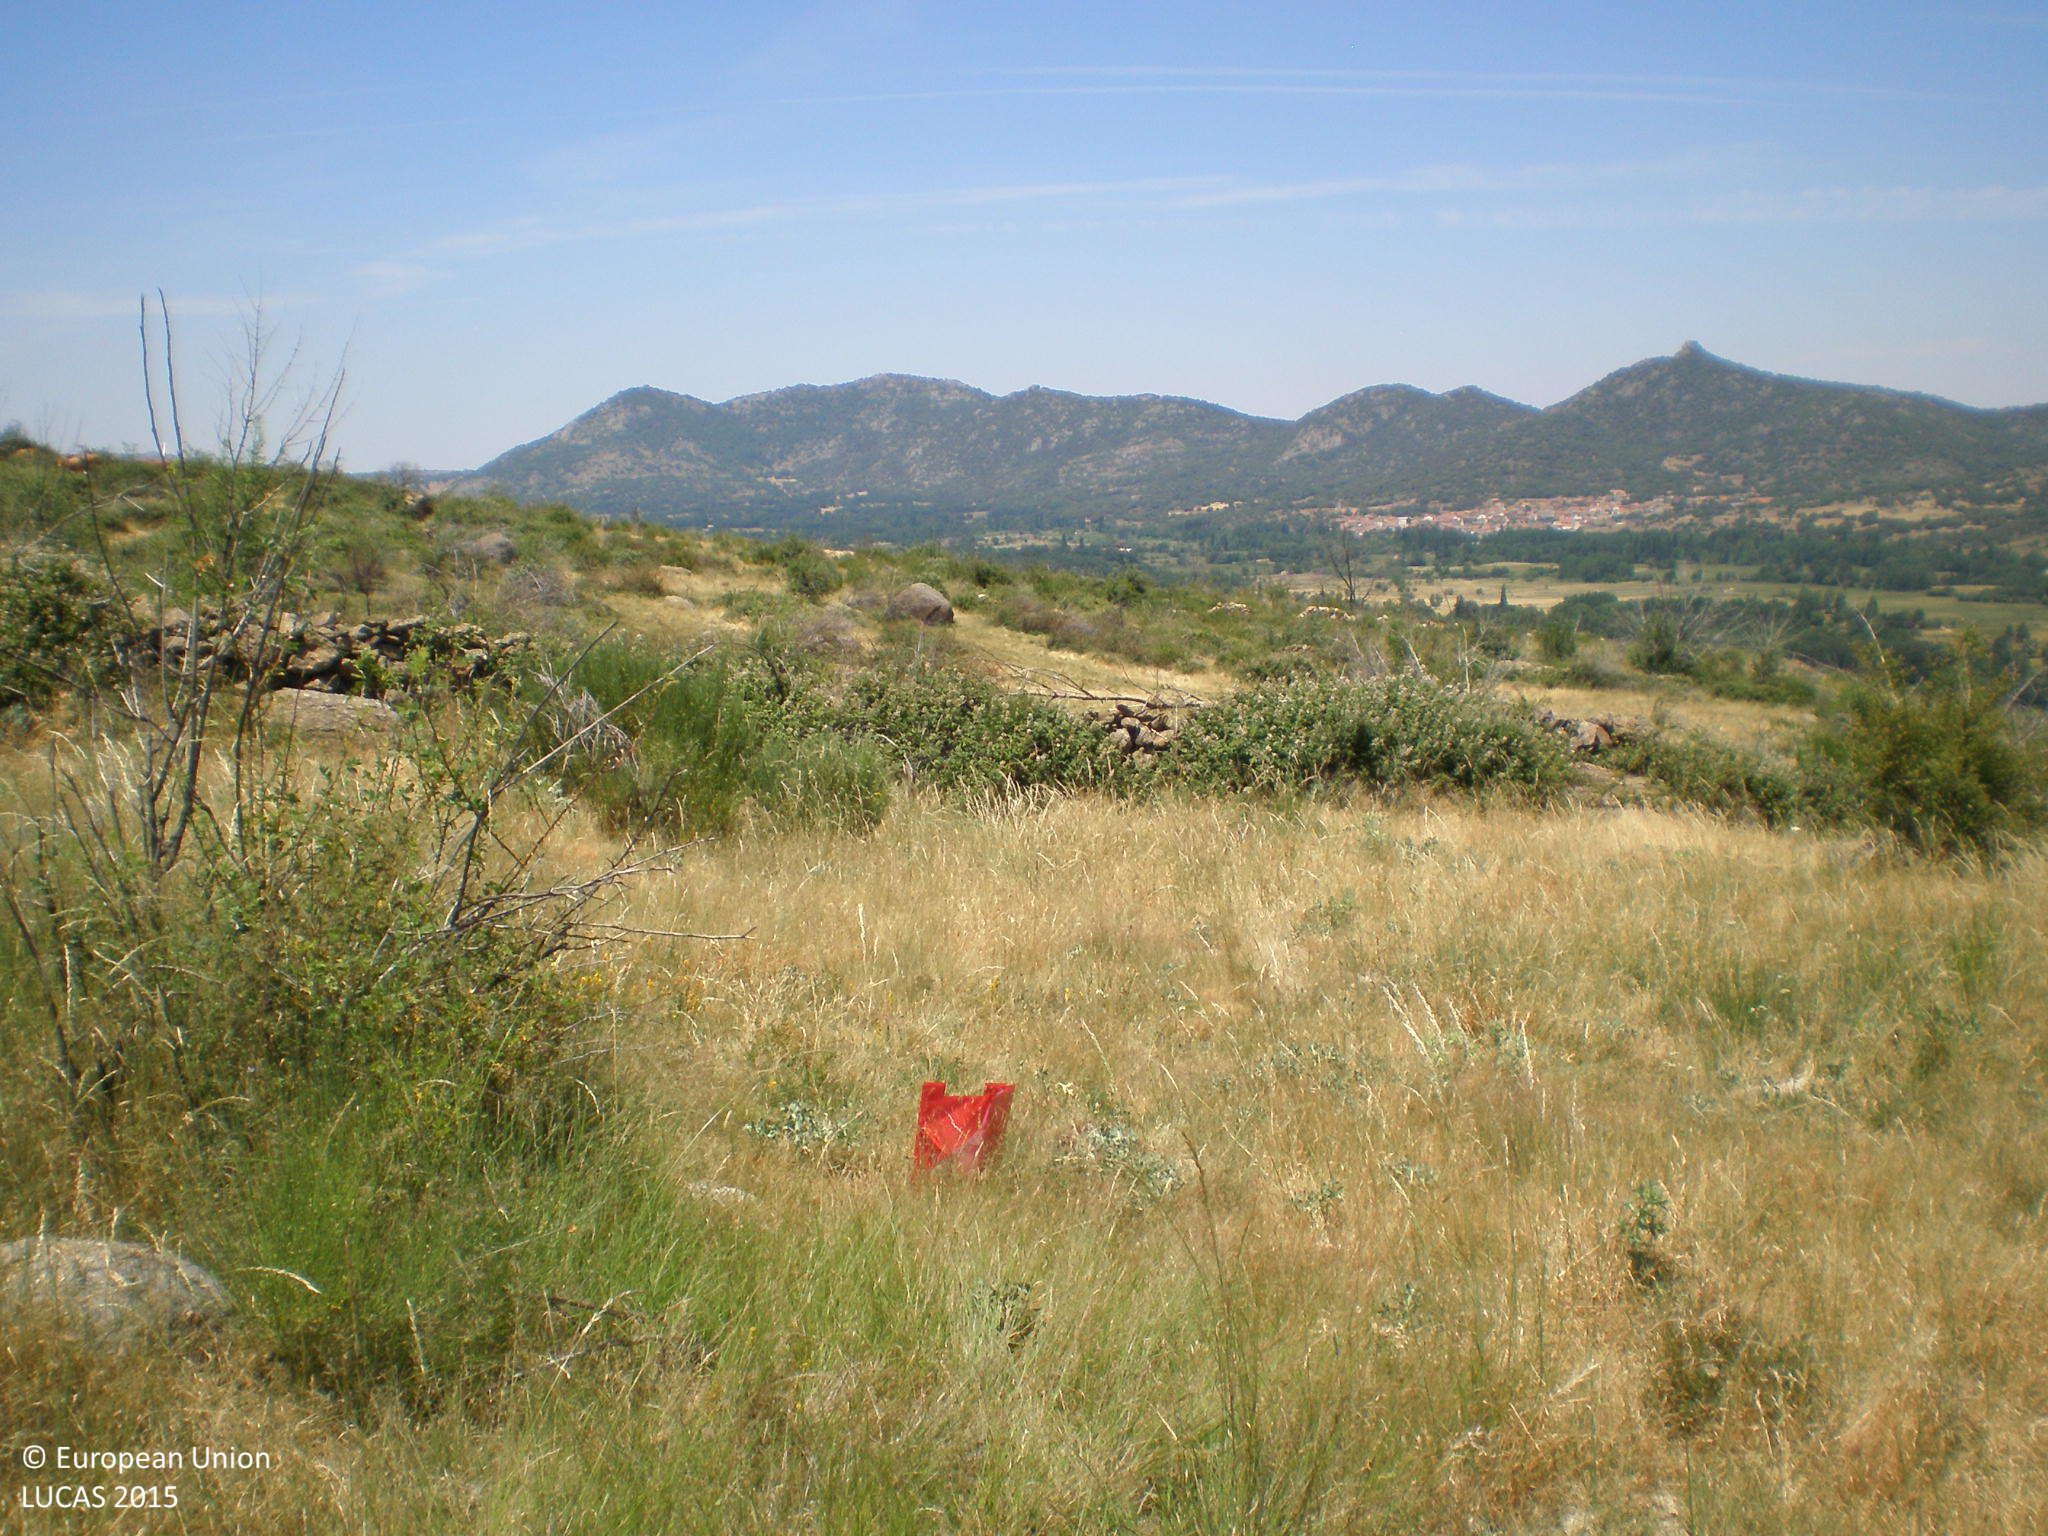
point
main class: Shrubland
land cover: Shrubland without tree cover
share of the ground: 50 - 75 %
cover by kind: shrubs 70 %, herbaceous plants 30 %
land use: Semi-natural and natural areas not in use
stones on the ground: < 10 %
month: June
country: ES
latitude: 40.3924
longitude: -5.5828
